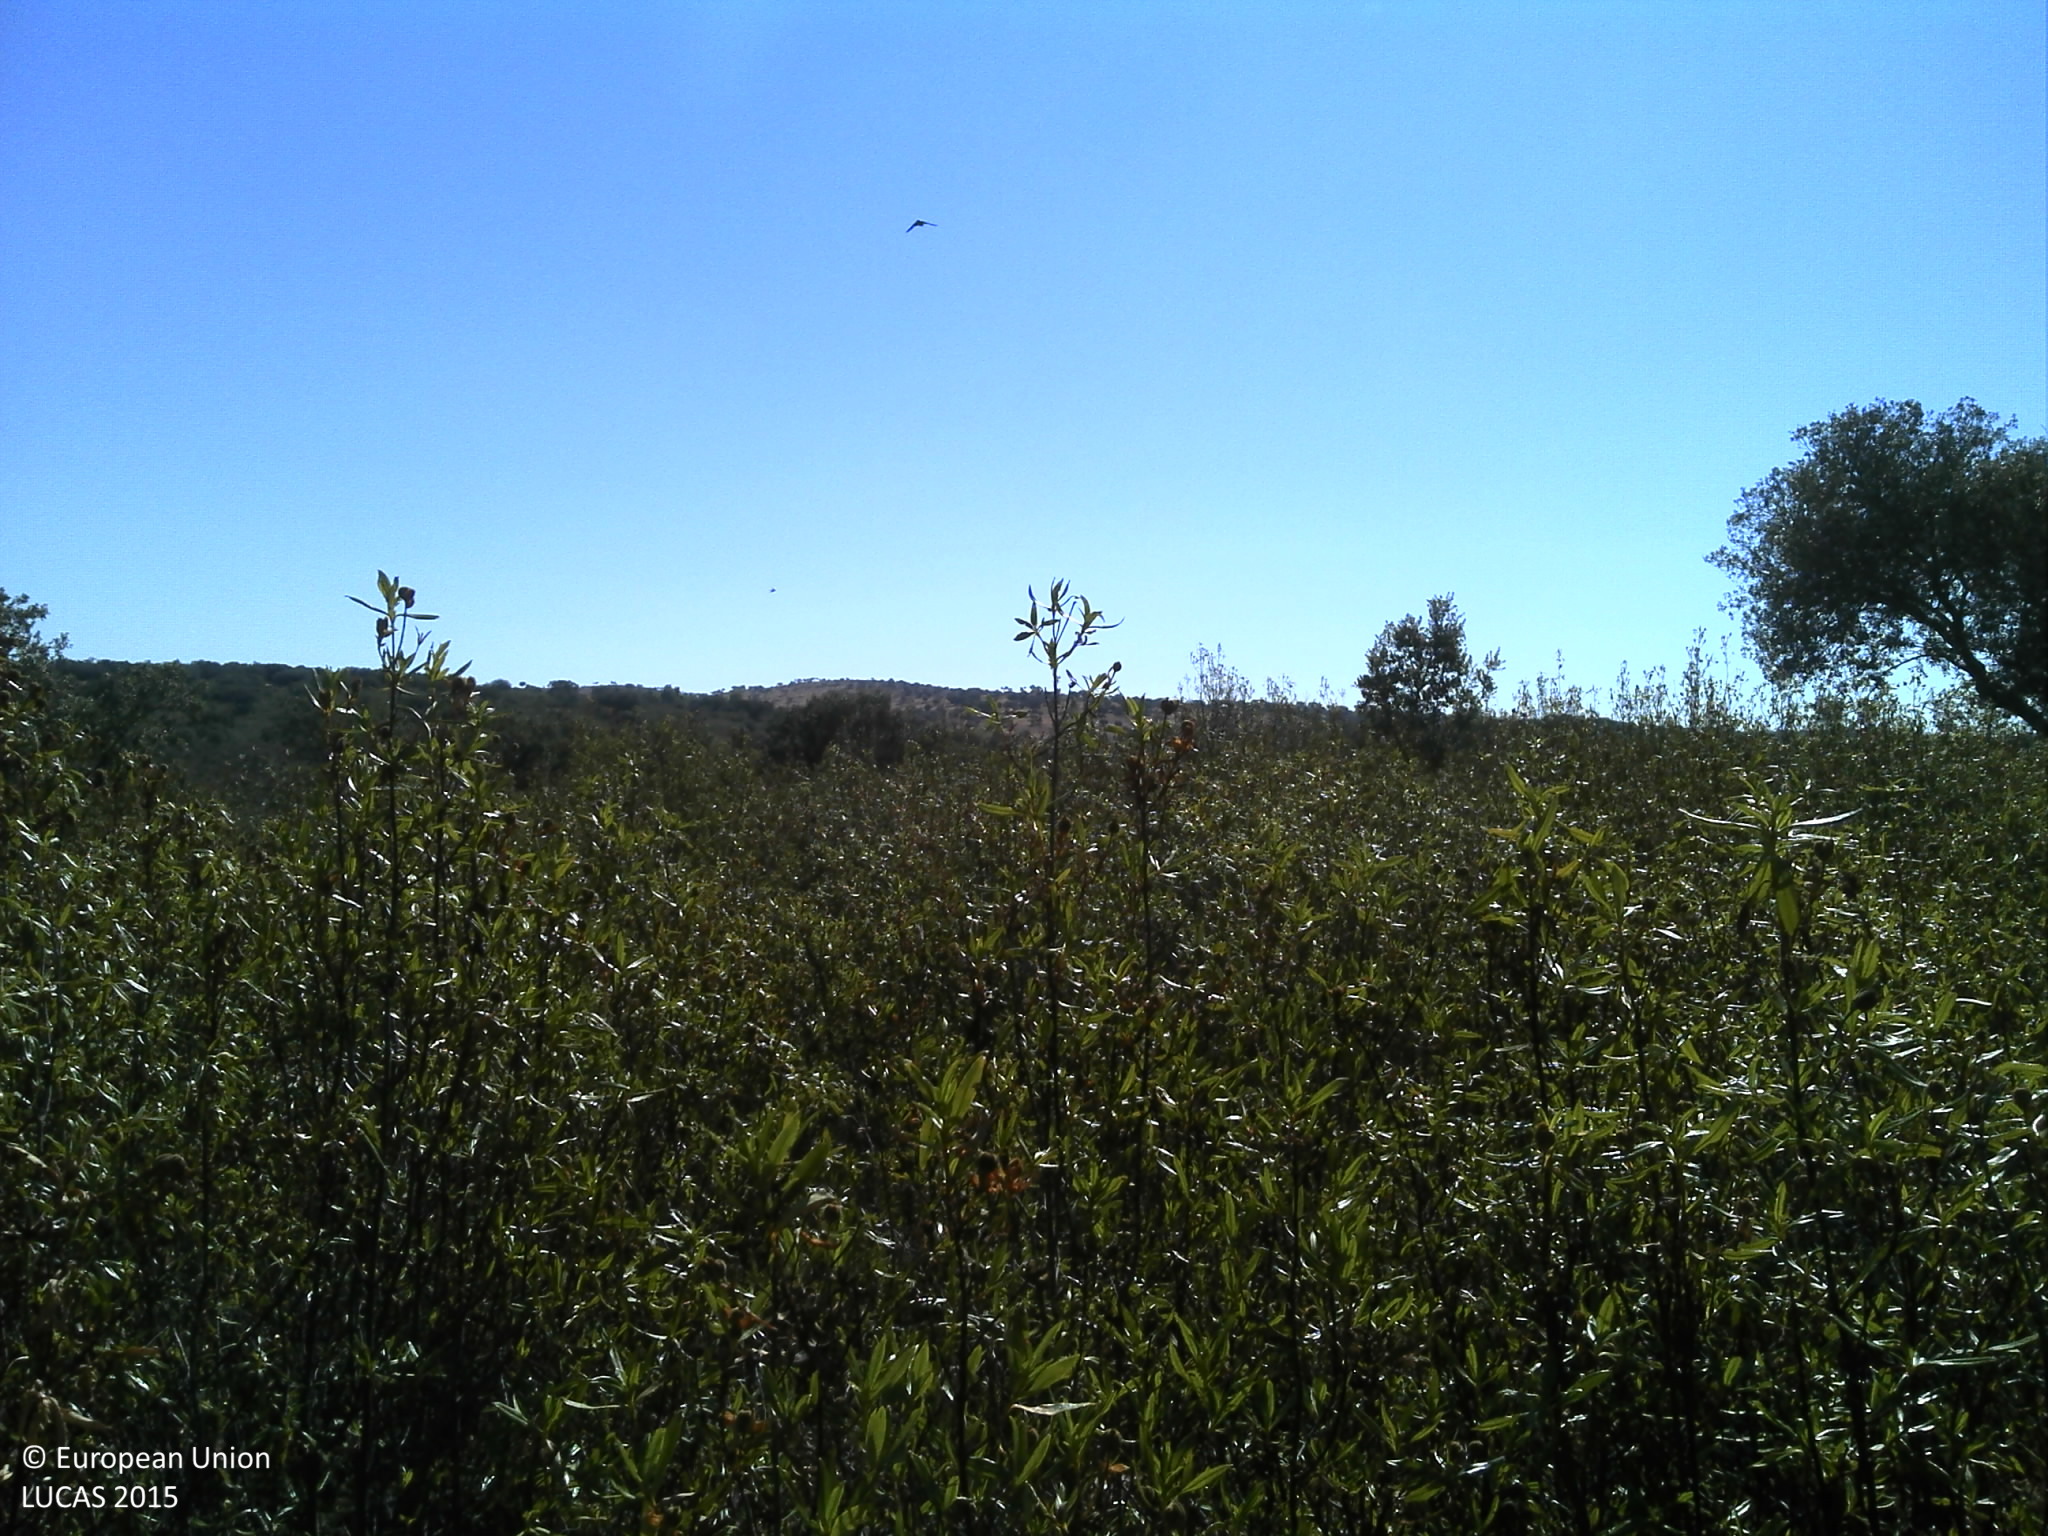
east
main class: Woodland
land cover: Broadleaved woodland
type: broadleaved evergreen forest
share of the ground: 10 - 25 %
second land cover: Shrubland without tree cover
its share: > 75 %
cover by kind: shrubs 85 %, broadleaved forest trees 15 %
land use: Forestry
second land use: Agriculture (excluding fallow land and kitchen gardens)
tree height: > 5 m
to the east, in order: Broadleaved woodland; Shrubland without tree cover; Broadleaved woodland; Shrubland with sparse tree cover; Tracks; Shrubland without tree cover; Grassland with sparse tree/shrub cover; Broadleaved woodland; Grassland with sparse tree/shrub cover; Shrubland with sparse tree cover
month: July
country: PT
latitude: 38.9230
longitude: -7.4873
